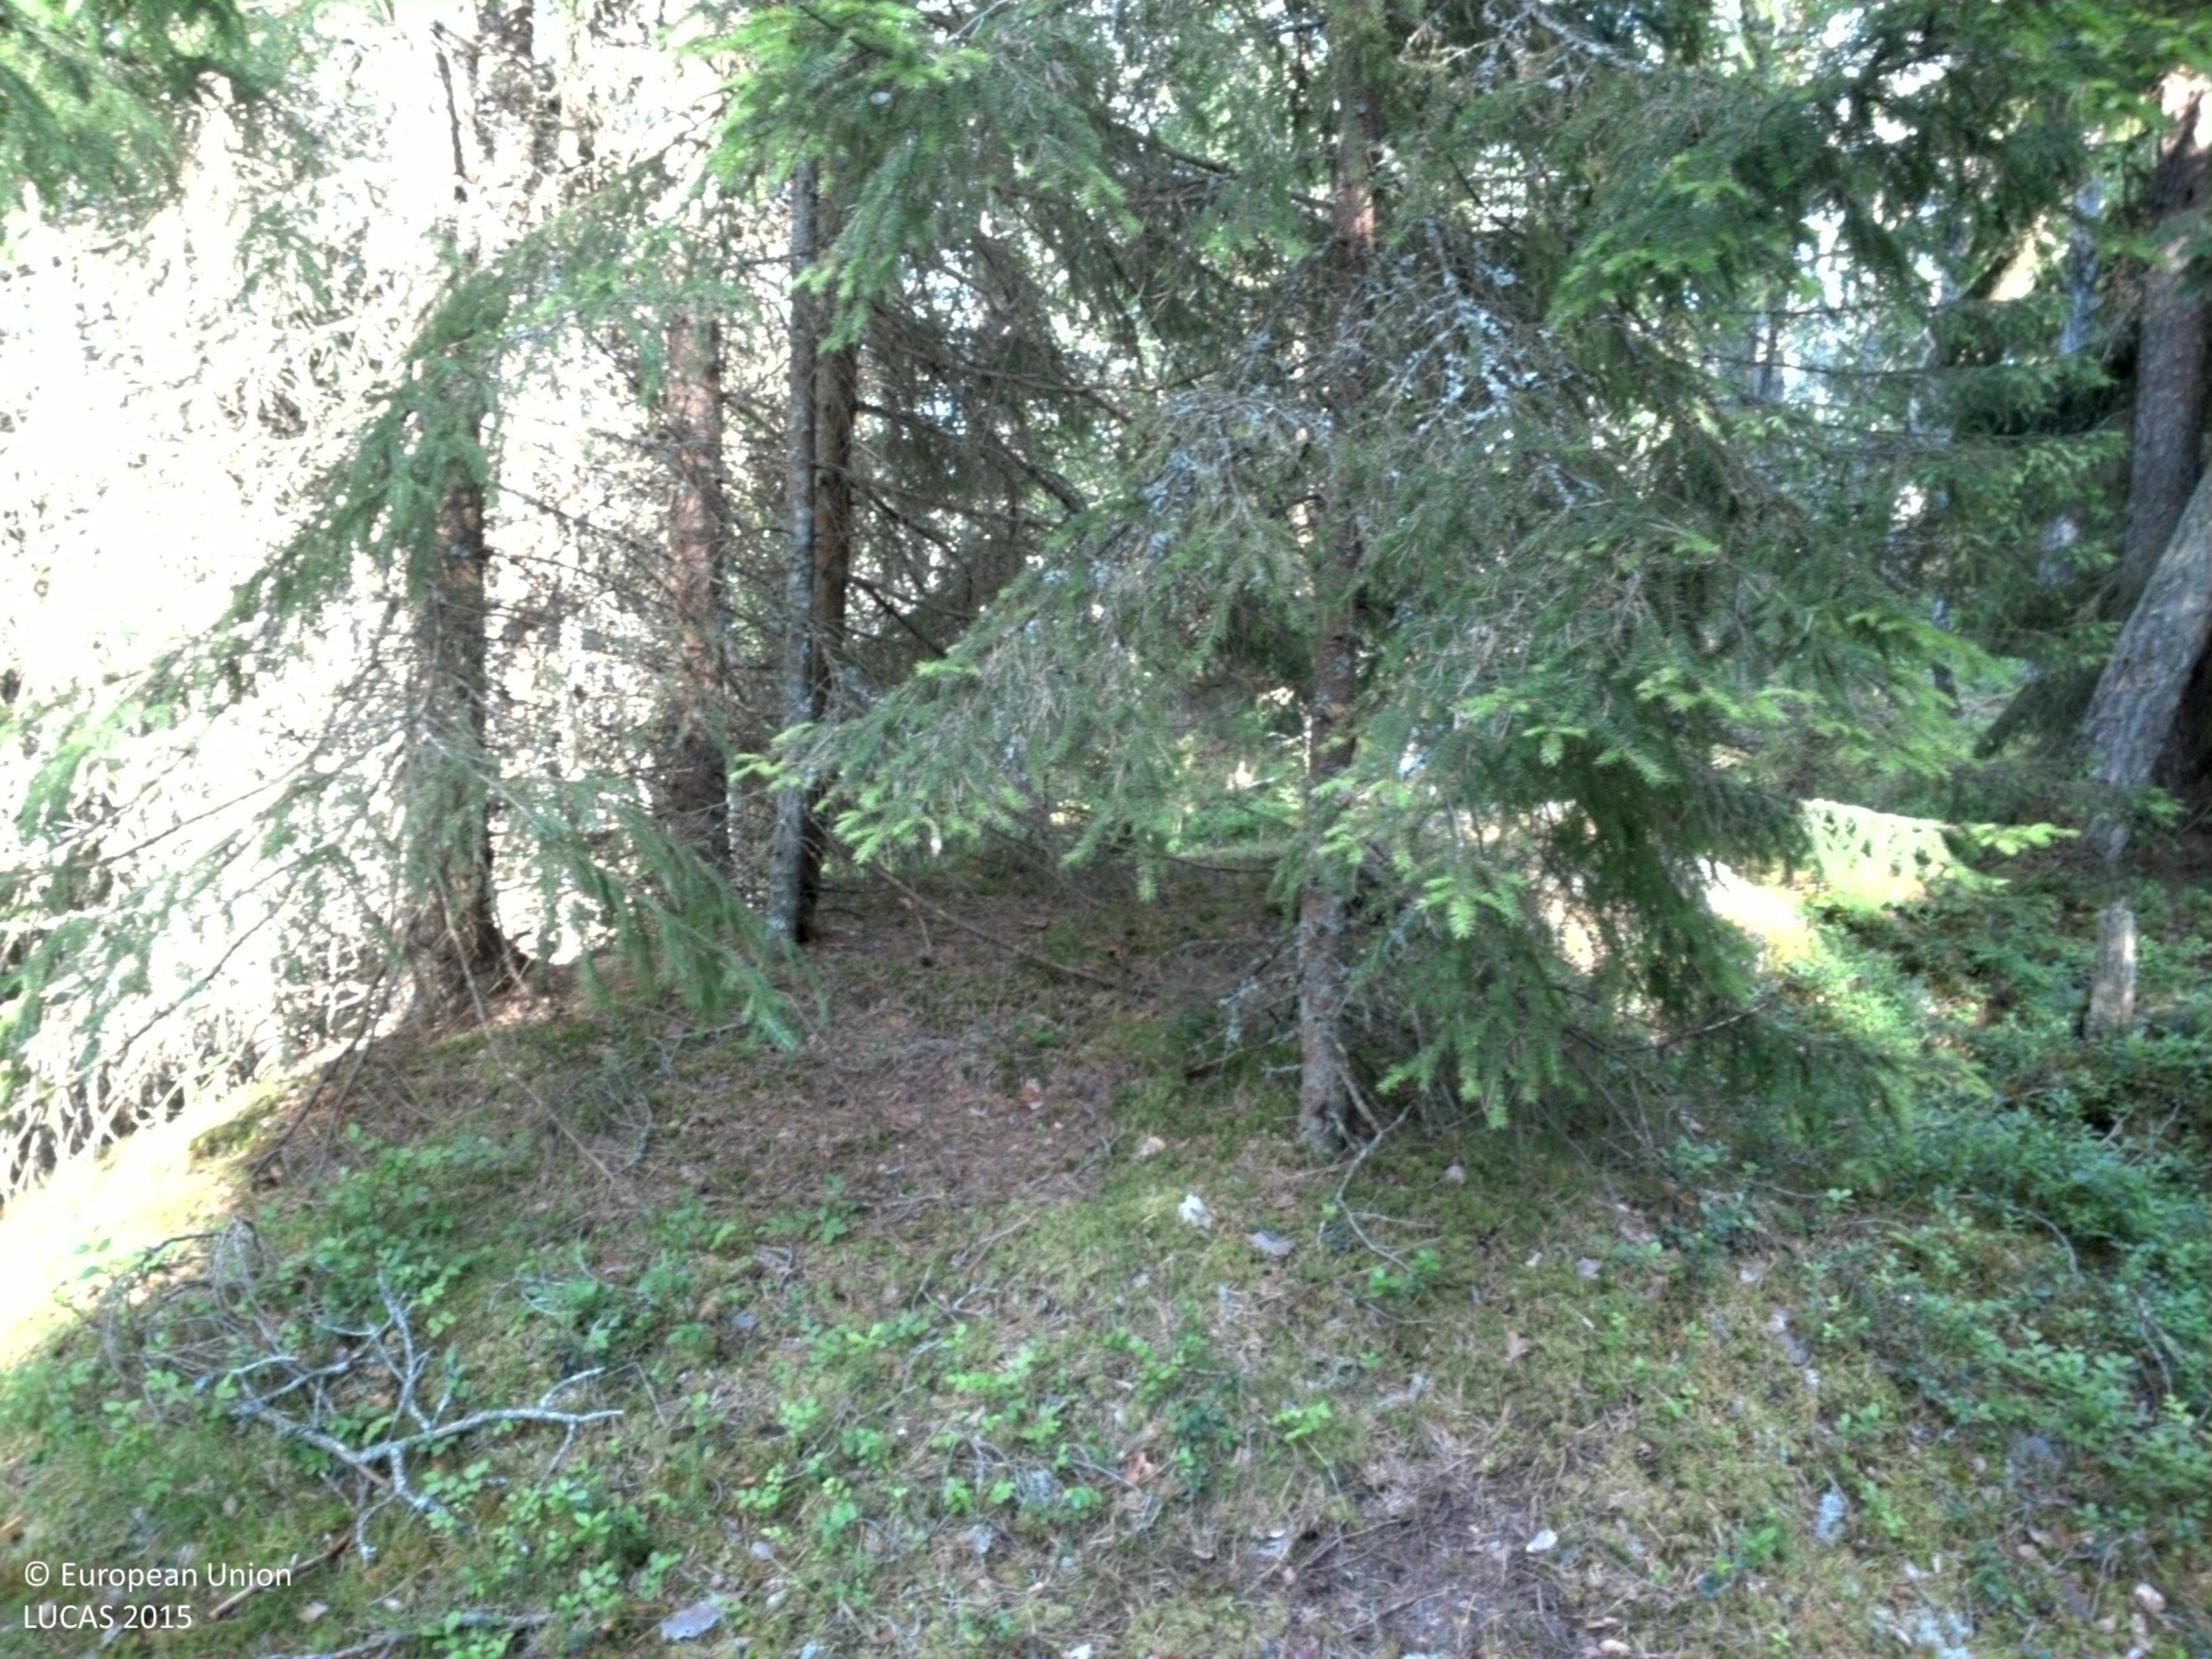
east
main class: Woodland
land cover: Pine dominated coniferous woodland
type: boreal forest
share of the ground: 50 - 75 %
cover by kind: coniferous forest trees 70 %, lichens and mosses 20 %, shrubs 10 %
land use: Forestry
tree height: > 5 m
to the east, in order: Pine dominated coniferous woodland; Spruce dominated coniferous woodland
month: July
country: SE
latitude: 57.7138
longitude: 14.4434
